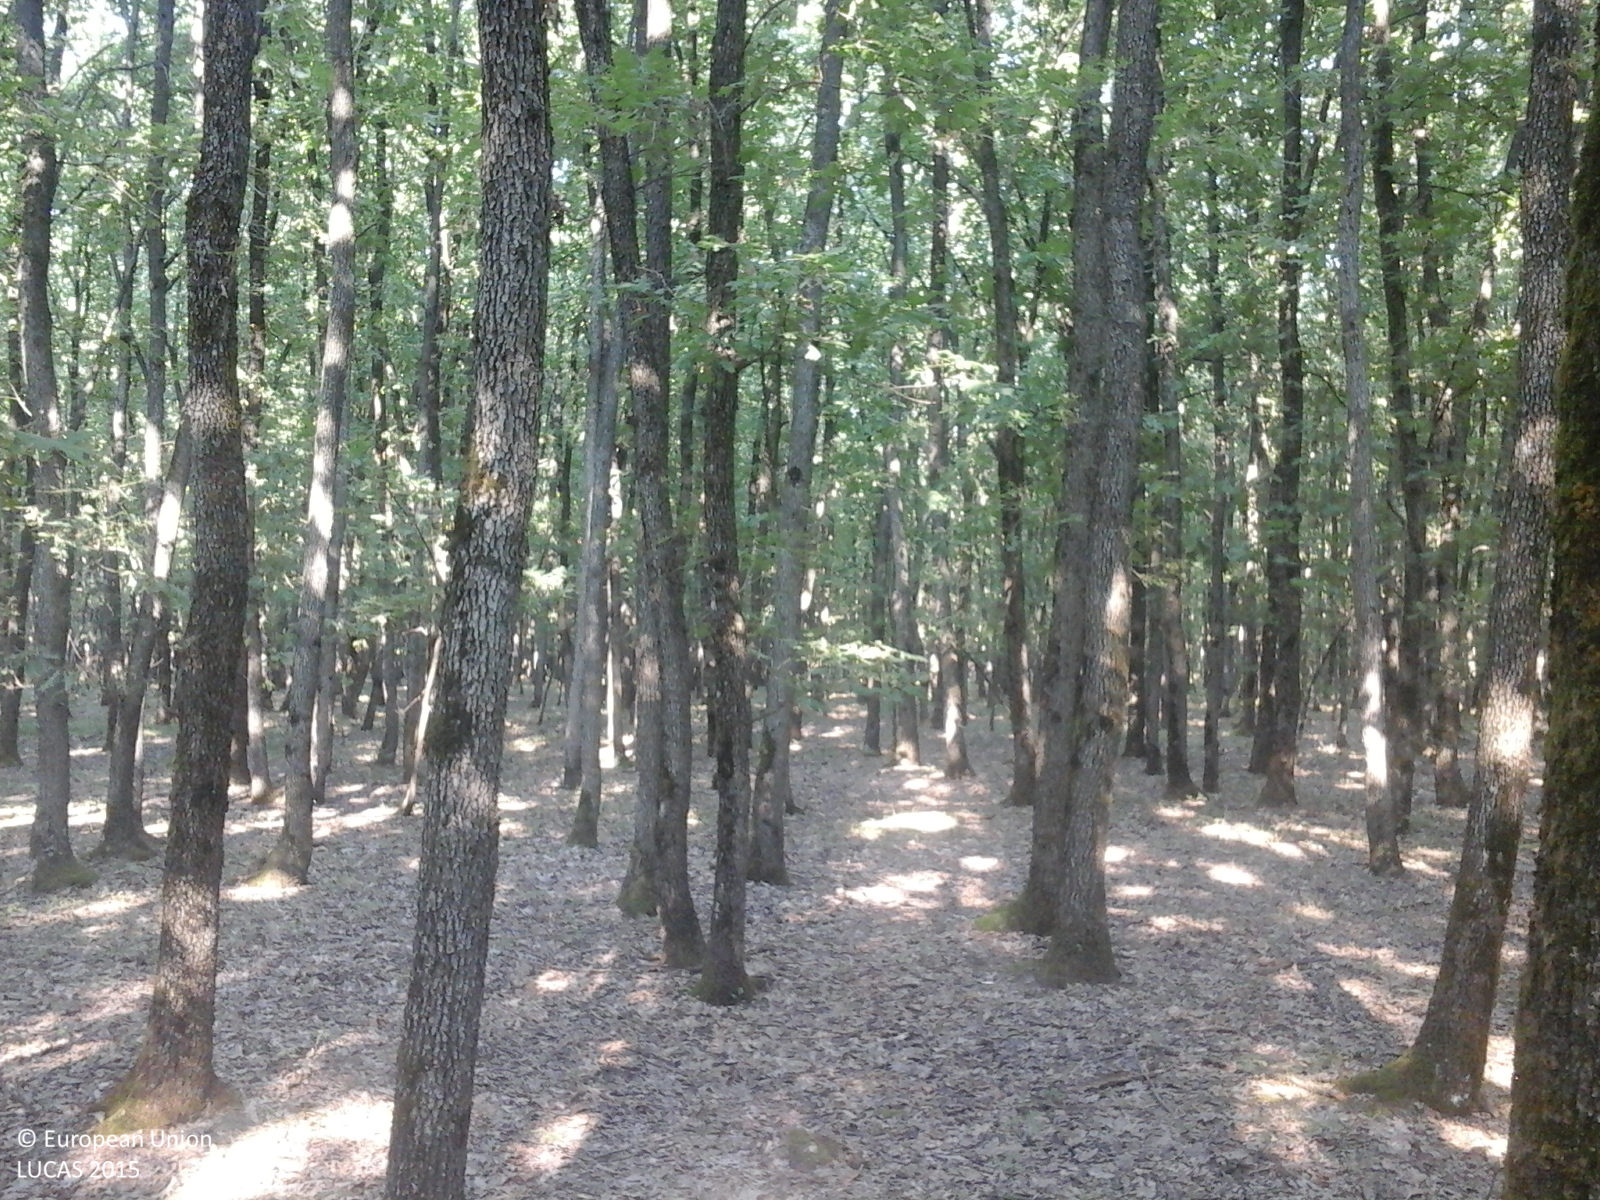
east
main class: Woodland
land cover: Broadleaved woodland
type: acidophilous oak and oak-birch forest
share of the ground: > 75 %
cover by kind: broadleaved forest trees 100 %
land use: Forestry
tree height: > 5 m
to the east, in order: Broadleaved woodland; Tracks; Broadleaved woodland
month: July
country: RO
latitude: 44.6034
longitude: 24.5238
